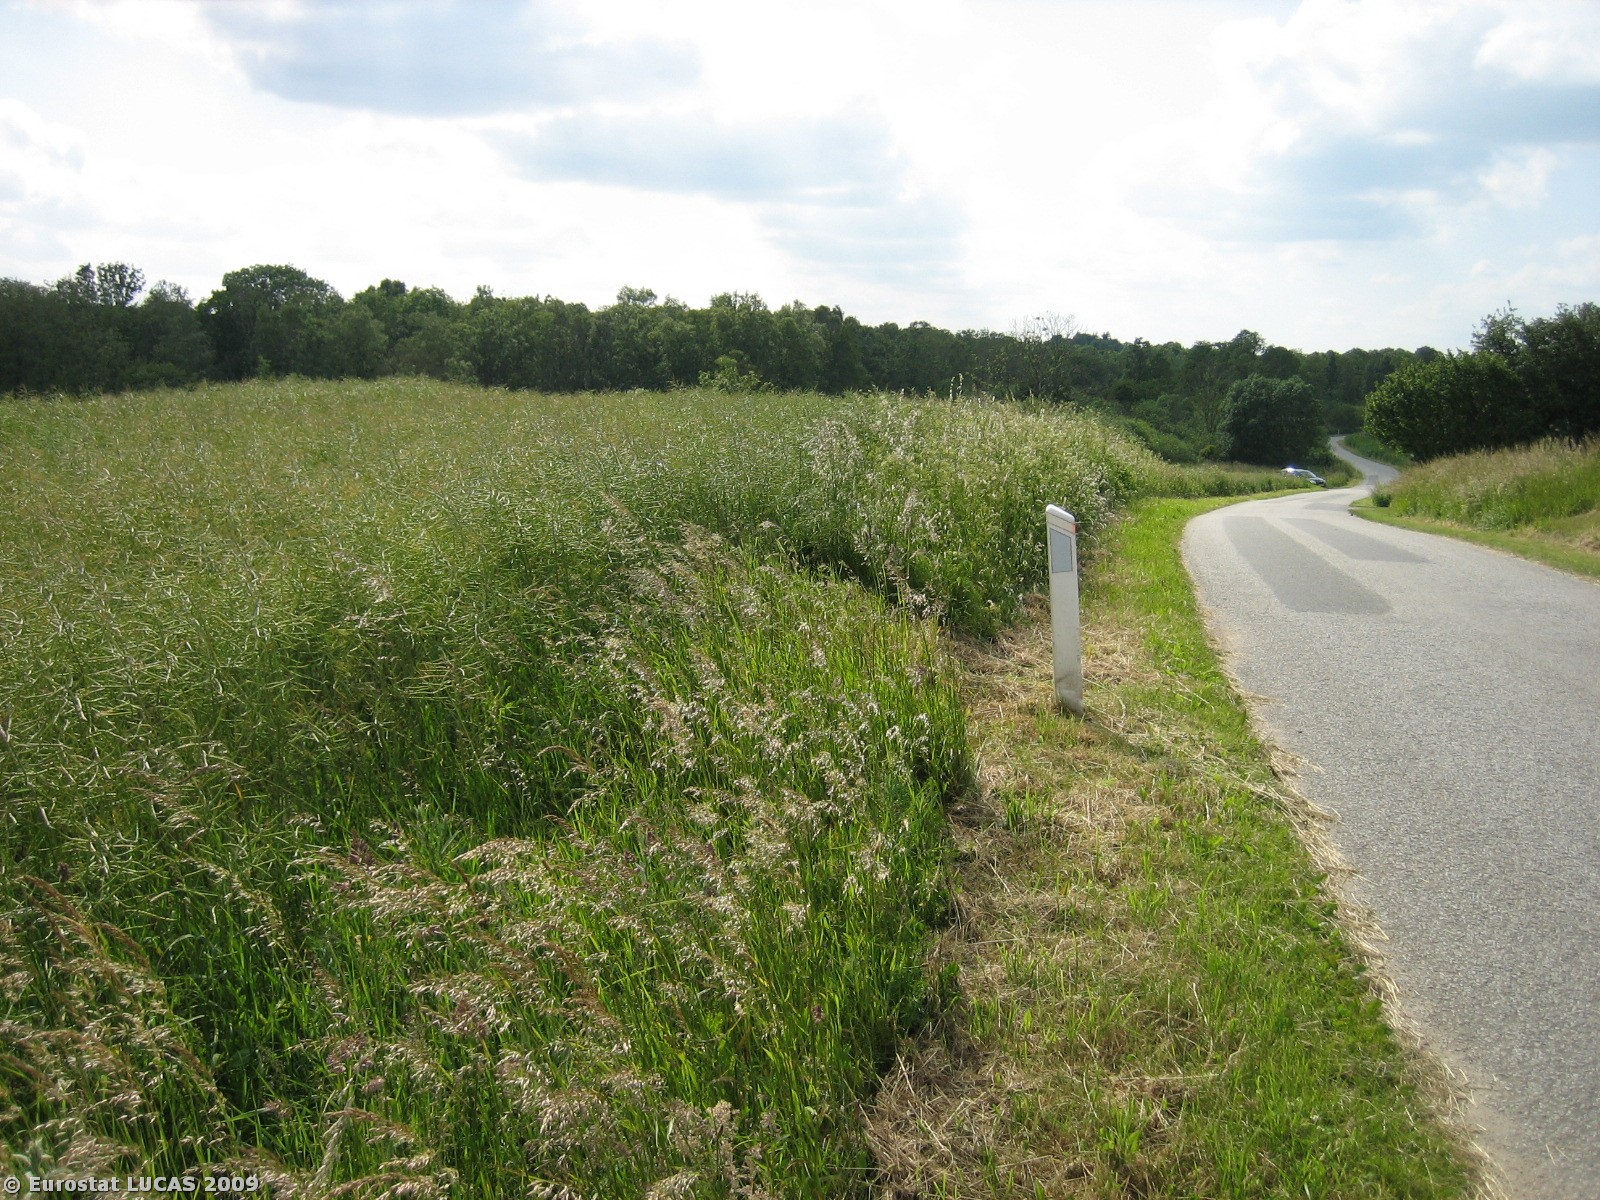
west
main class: Cropland
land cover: Rape and turnip rape
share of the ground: > 75 %
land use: Agriculture (excluding fallow land and kitchen gardens)
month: June
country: DK
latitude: 55.7563
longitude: 9.9841
